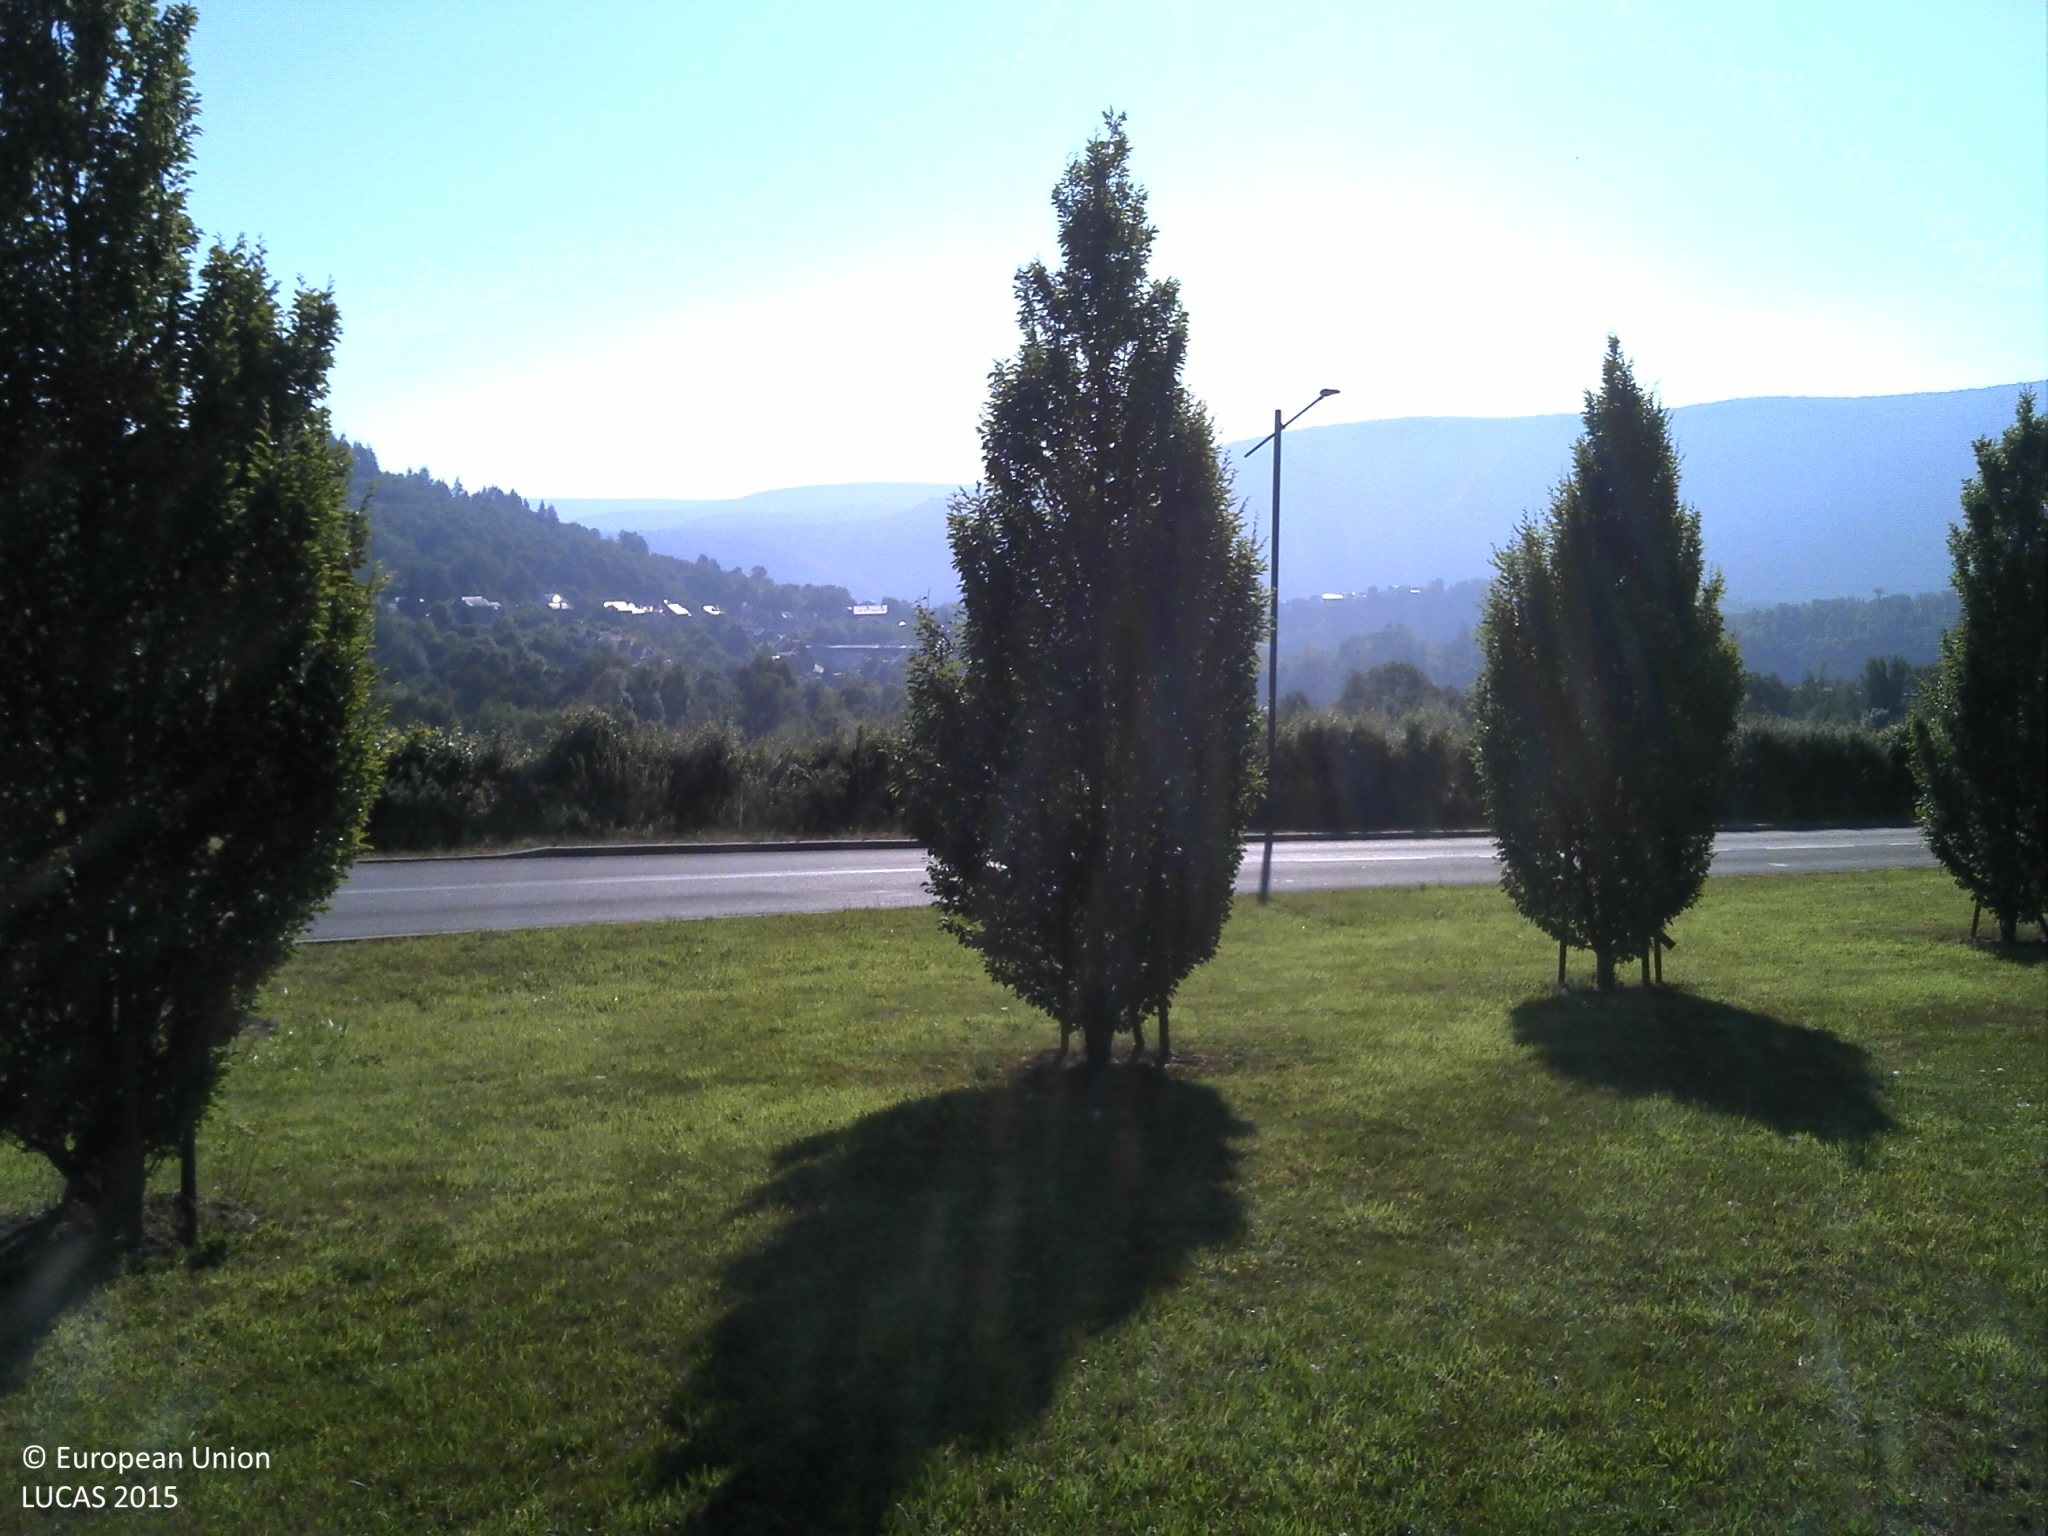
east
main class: Grassland
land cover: Grassland with sparse tree/shrub cover
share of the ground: > 75 %
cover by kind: herbaceous plants 95 %, broadleaved forest trees 5 %
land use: Semi-natural and natural areas not in use
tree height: < 5 m
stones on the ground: > 50 %
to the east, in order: Grassland with sparse tree/shrub cover; Grassland without tree/shrub cover; Paved roads, cycling and walking lanes; Managed hedges; Grassland without tree/shrub cover
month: June
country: FR
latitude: 49.9881
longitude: 4.6824
